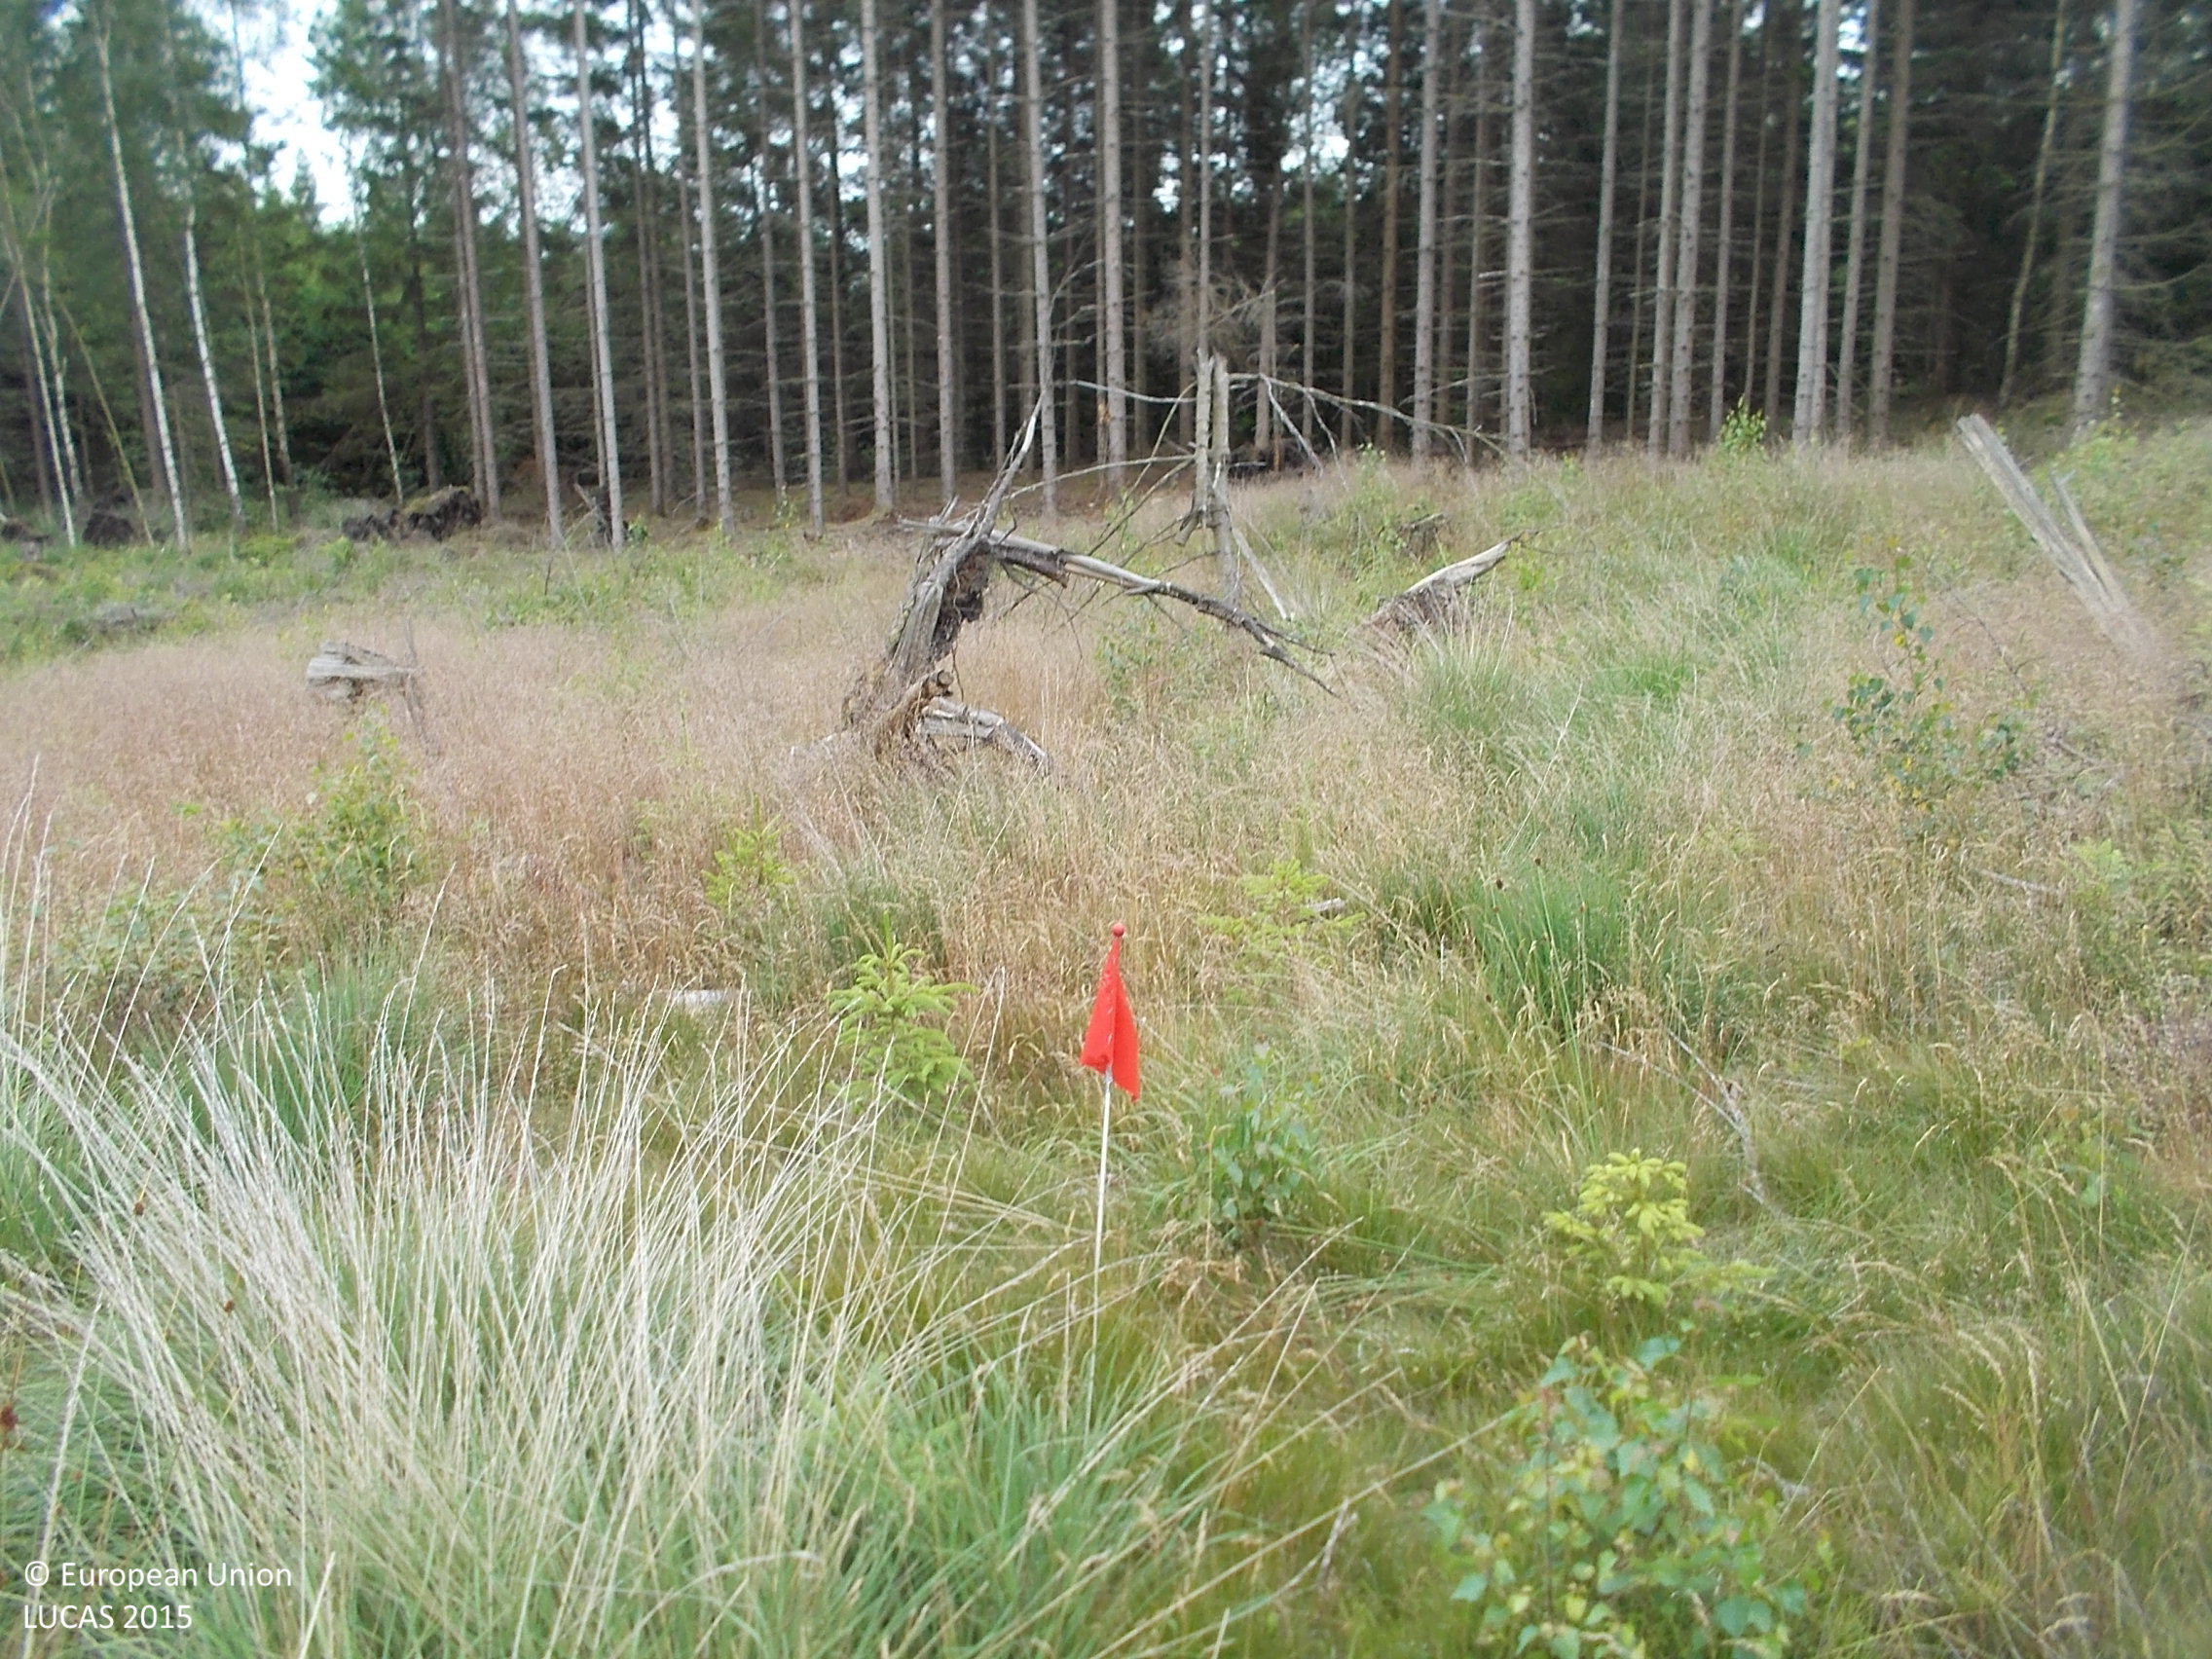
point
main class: Grassland
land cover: Grassland with sparse tree/shrub cover
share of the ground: > 75 %
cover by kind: herbaceous plants 75 %, coniferous forest trees 5 %, shrubs 5 %, lichens and mosses 5 %, unconsolidated bare surface 5 %
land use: Forestry
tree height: < 5 m
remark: Clear cut
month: July
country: SE
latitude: 57.2649
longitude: 12.2683
